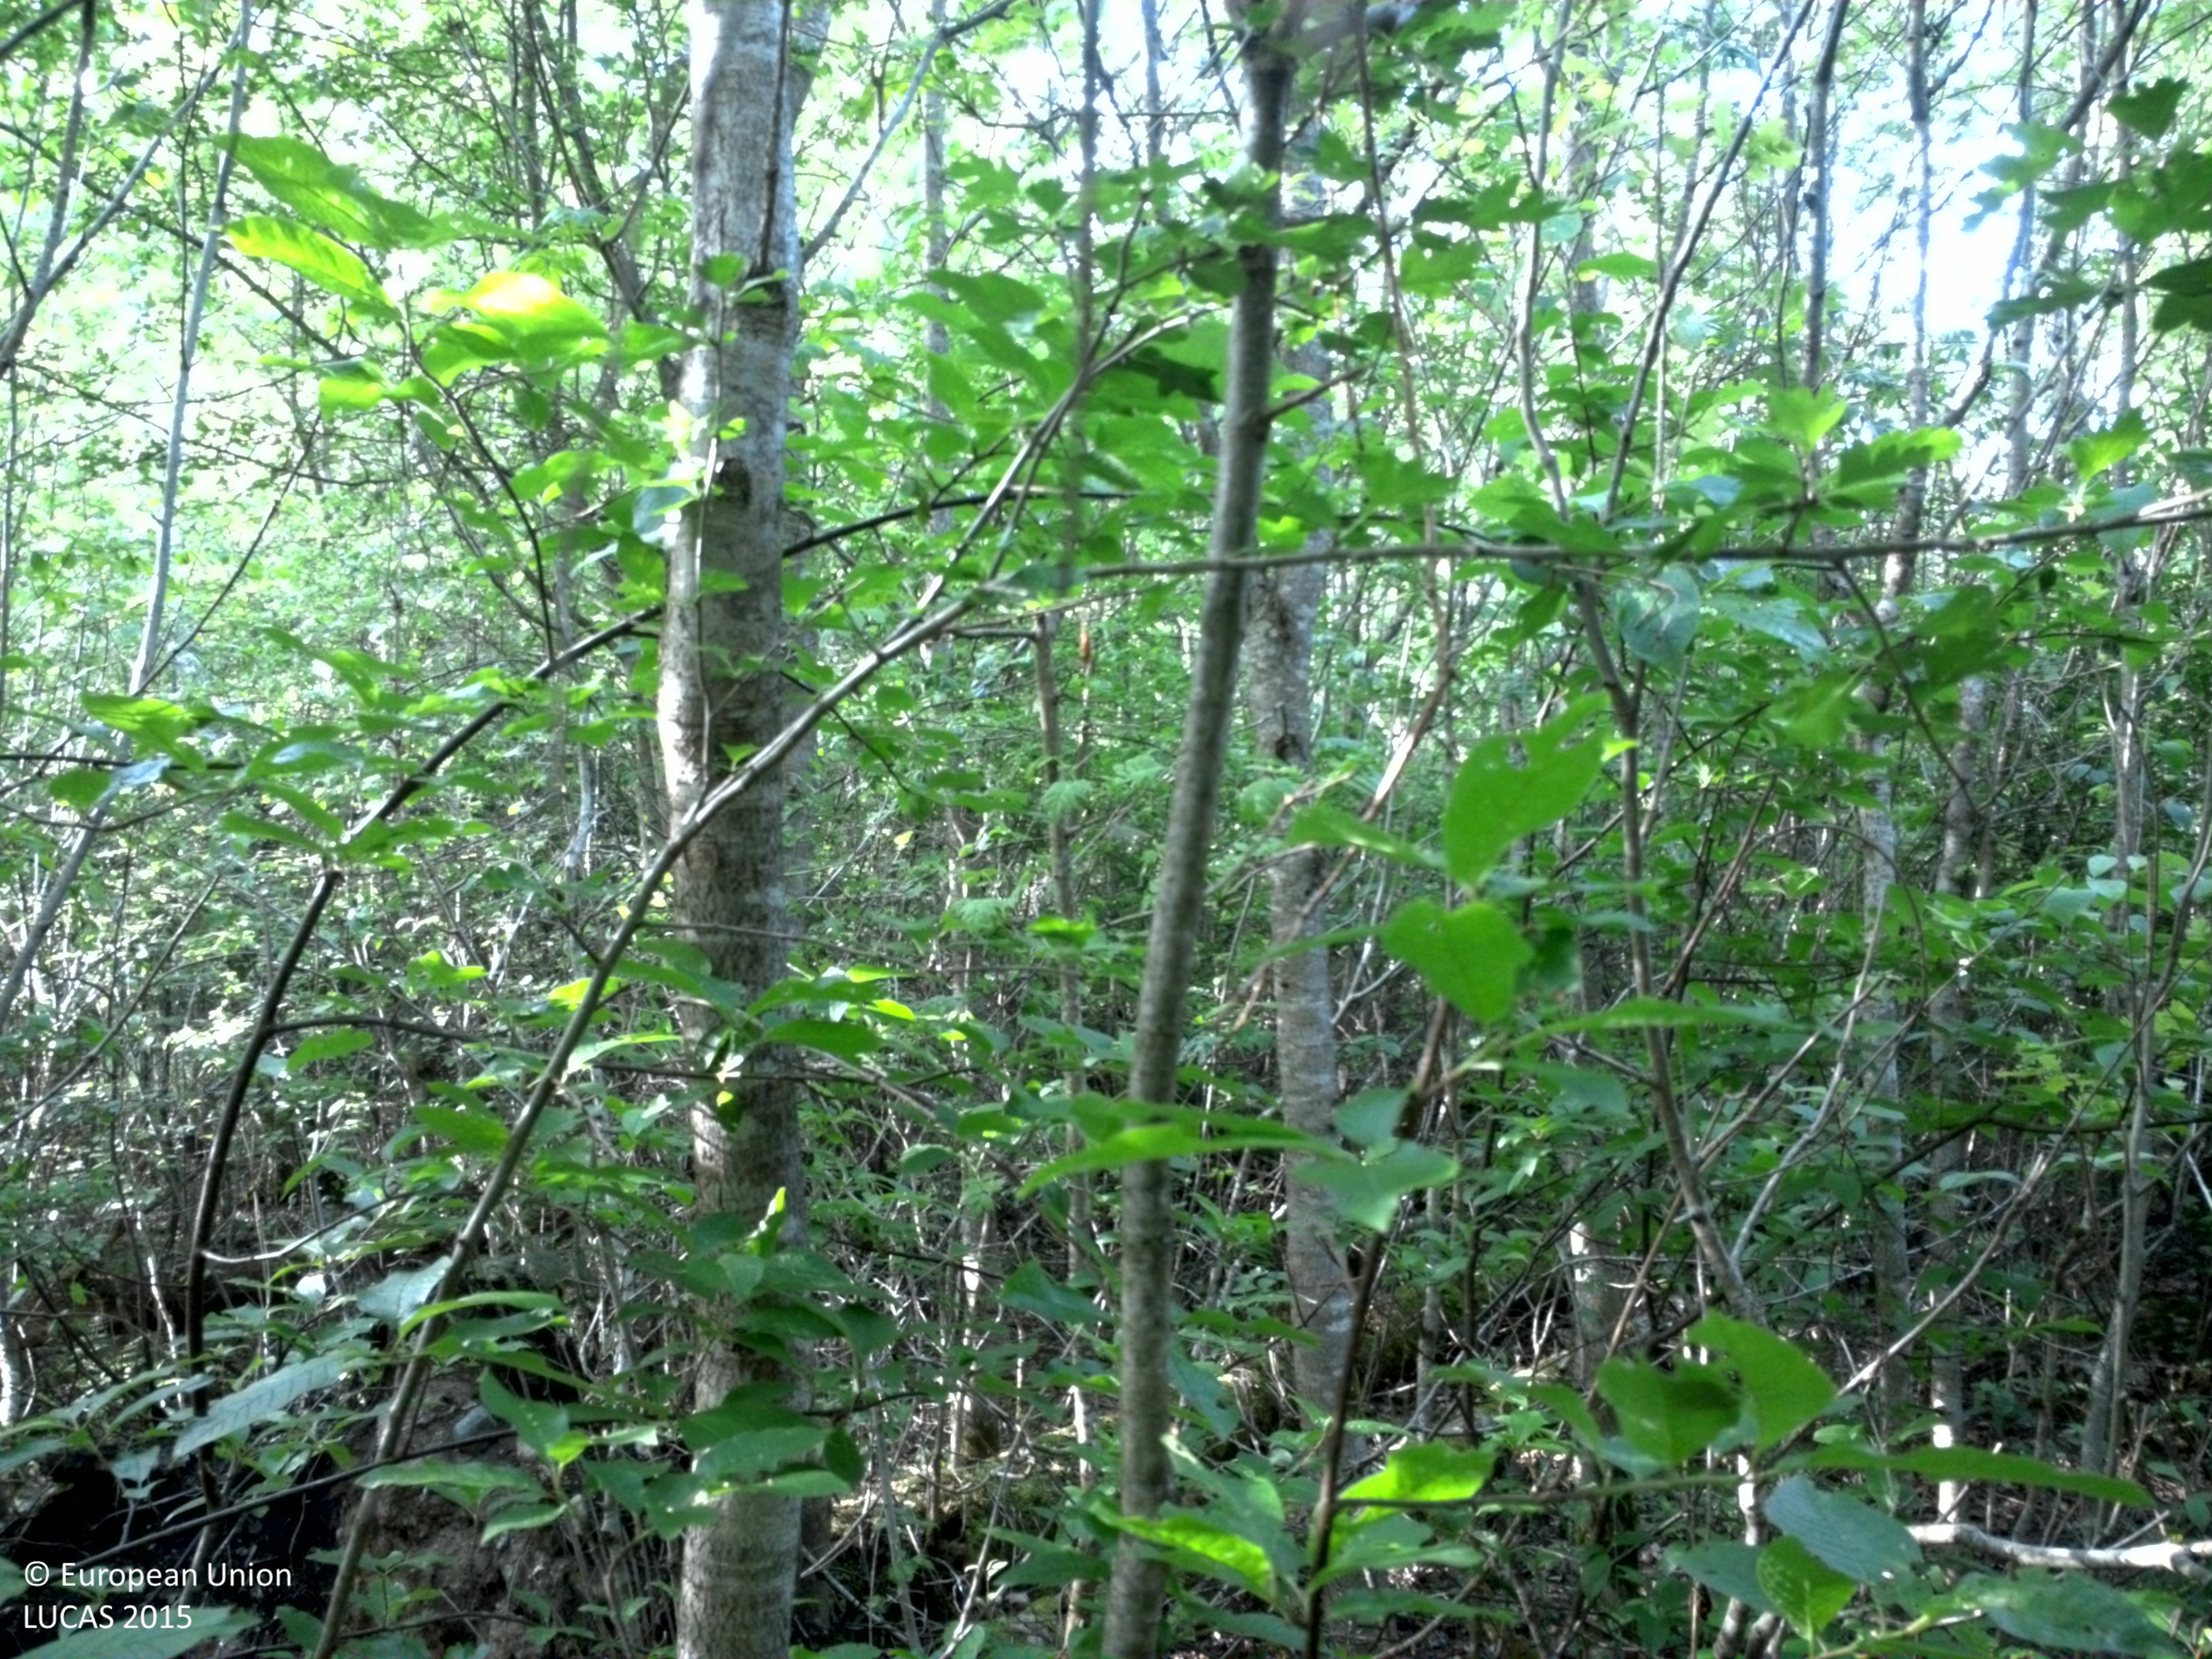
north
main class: Woodland
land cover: Broadleaved woodland
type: boreal forest
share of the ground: > 75 %
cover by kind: broadleaved forest trees 90 %, herbaceous plants 5 %, unconsolidated bare surface 5 %
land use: Forestry
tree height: > 5 m
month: June
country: SE
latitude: 56.7852
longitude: 14.7277
